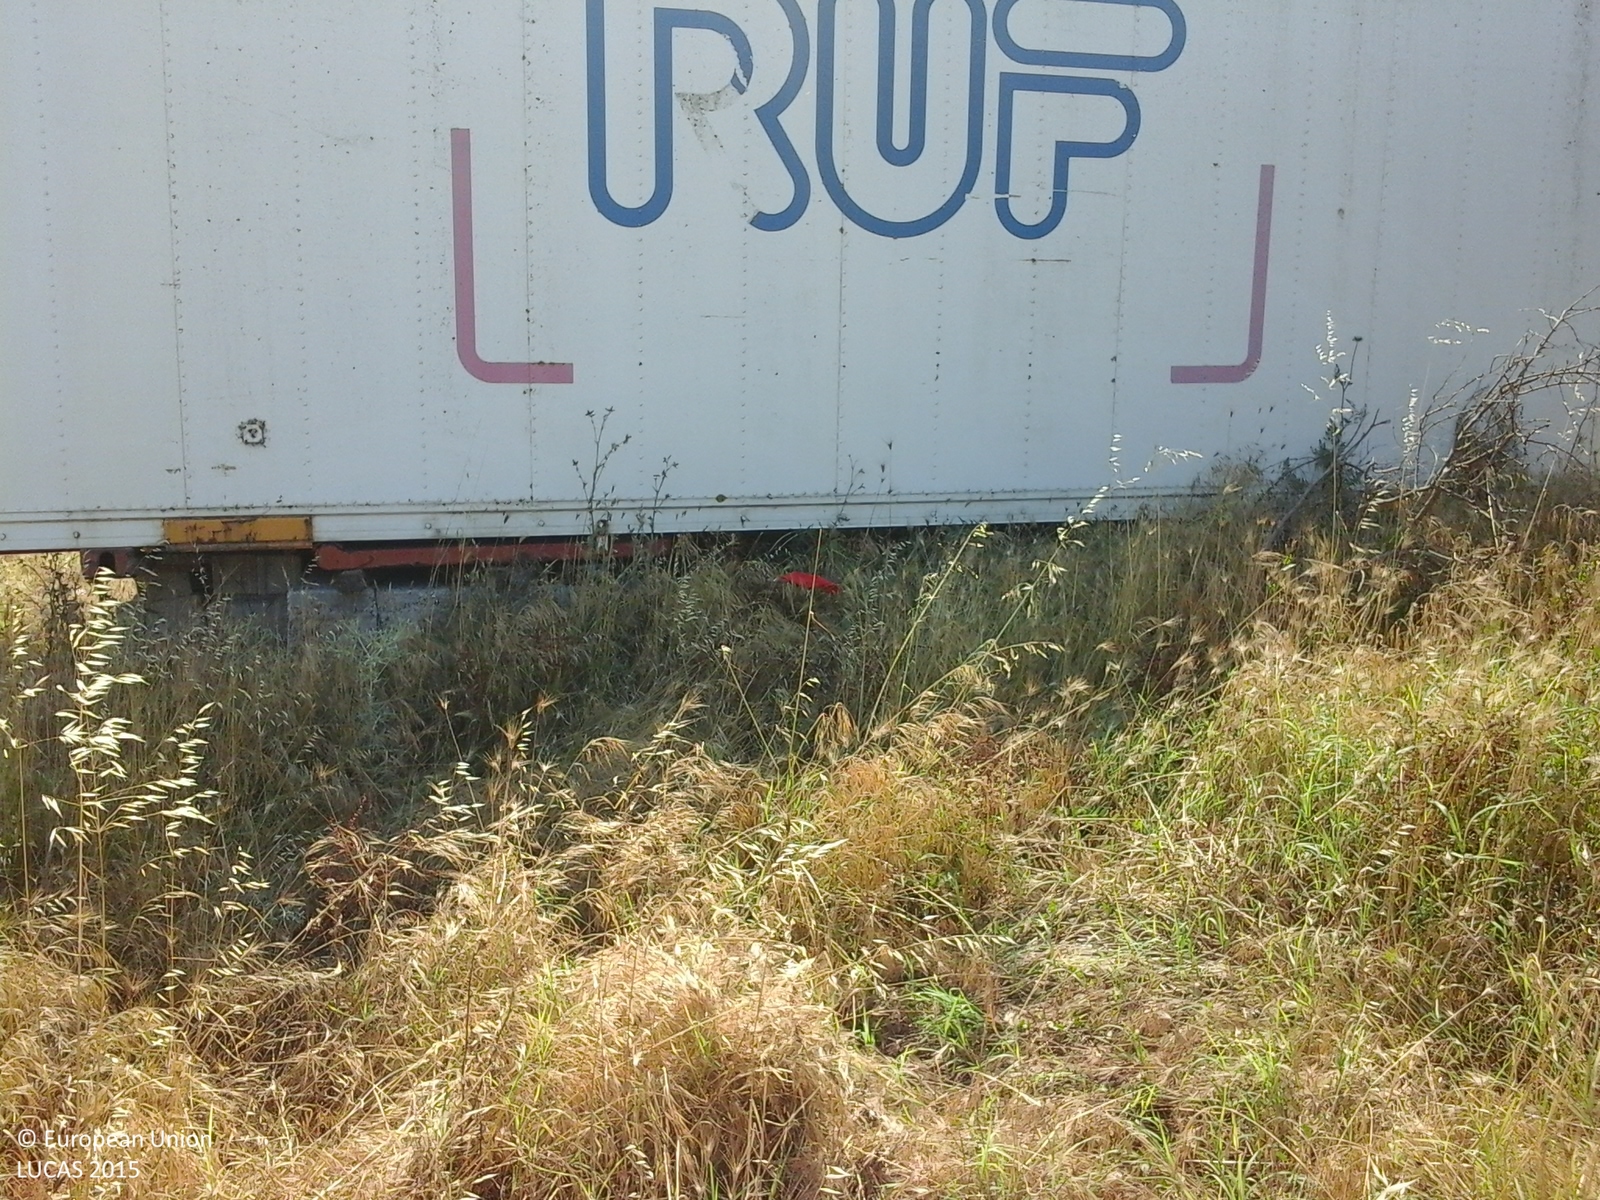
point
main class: Grassland
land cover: Spontaneously vegetated surfaces
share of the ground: > 75 %
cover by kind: herbaceous plants 100 %
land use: Semi-natural and natural areas not in use
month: June
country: GR
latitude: 40.6807
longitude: 22.9874
